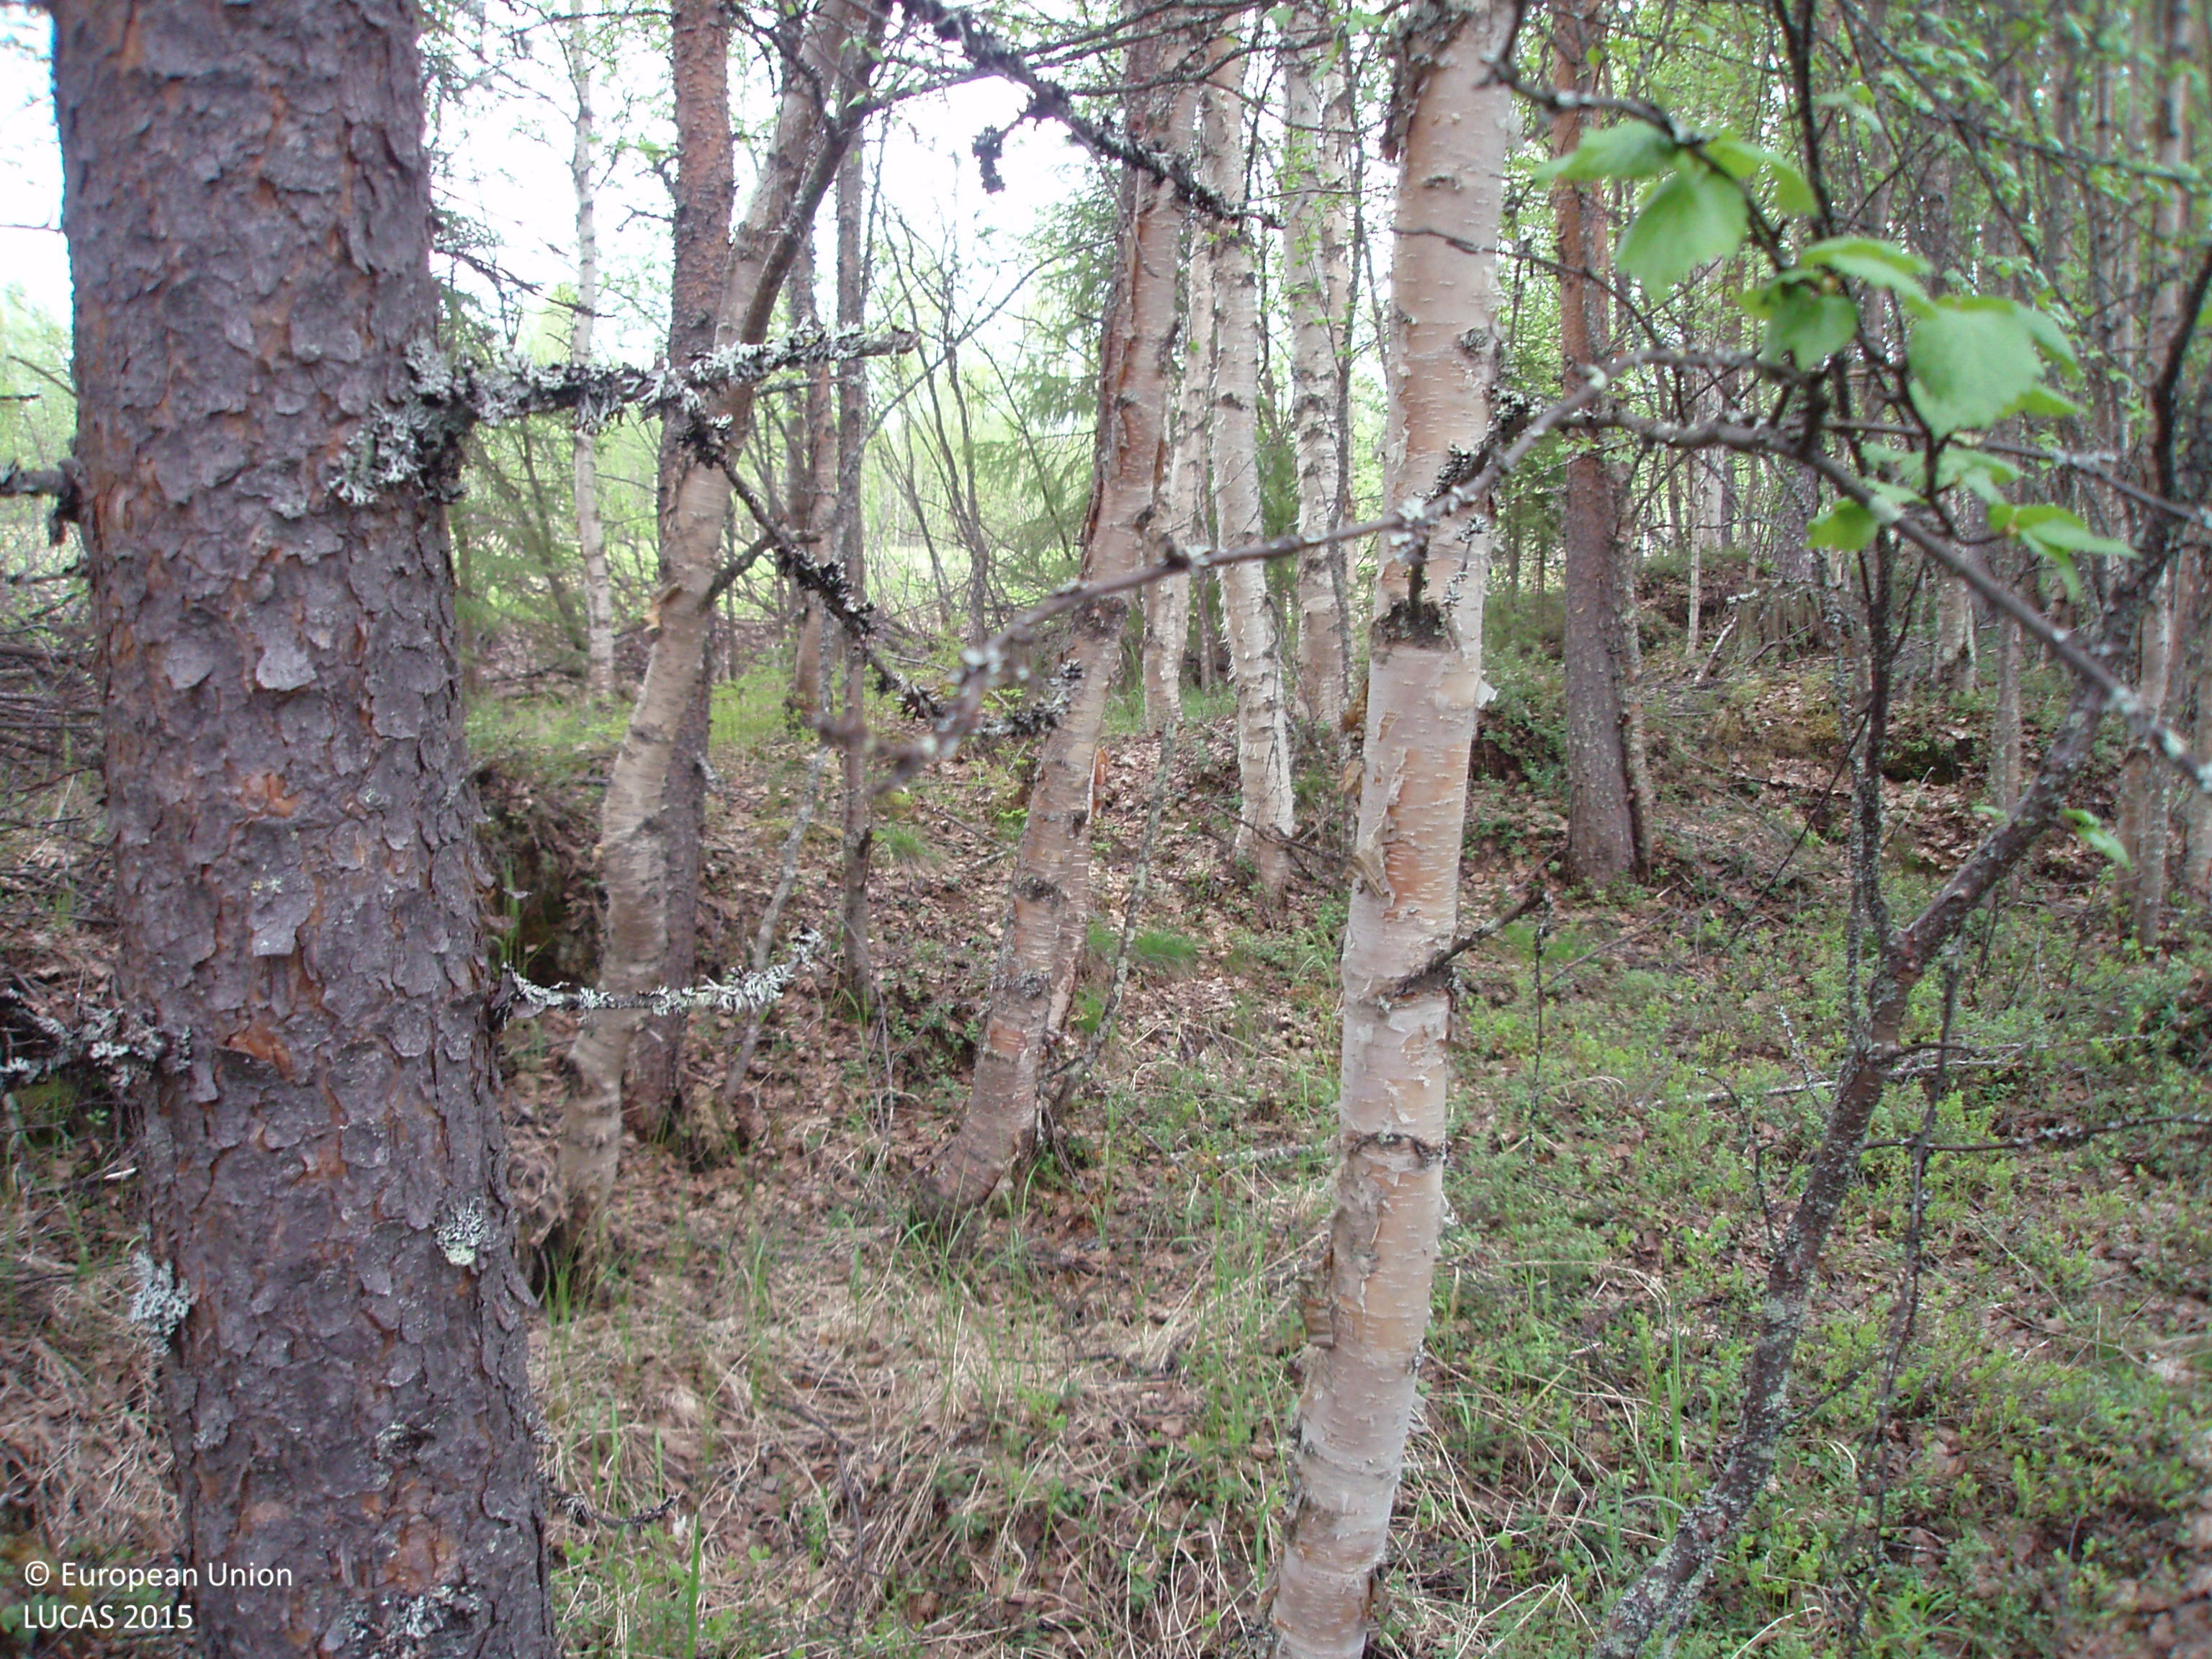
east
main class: Woodland
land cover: Other mixed woodland
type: boreal forest
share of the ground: > 75 %
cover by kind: broadleaved forest trees 50 %, coniferous forest trees 40 %, shrubs 5 %, herbaceous plants 5 %
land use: Forestry
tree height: > 5 m
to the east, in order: Other mixed woodland; Grassland without tree/shrub cover; Temporary grasslands; Broadleaved woodland; Other mixed woodland; Pine dominated coniferous woodland; Electric lines; Pine dominated coniferous woodland; Tracks; Pine dominated coniferous woodland; Pine dominated mixed woodland
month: June
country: FI
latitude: 67.2589
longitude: 27.2728
